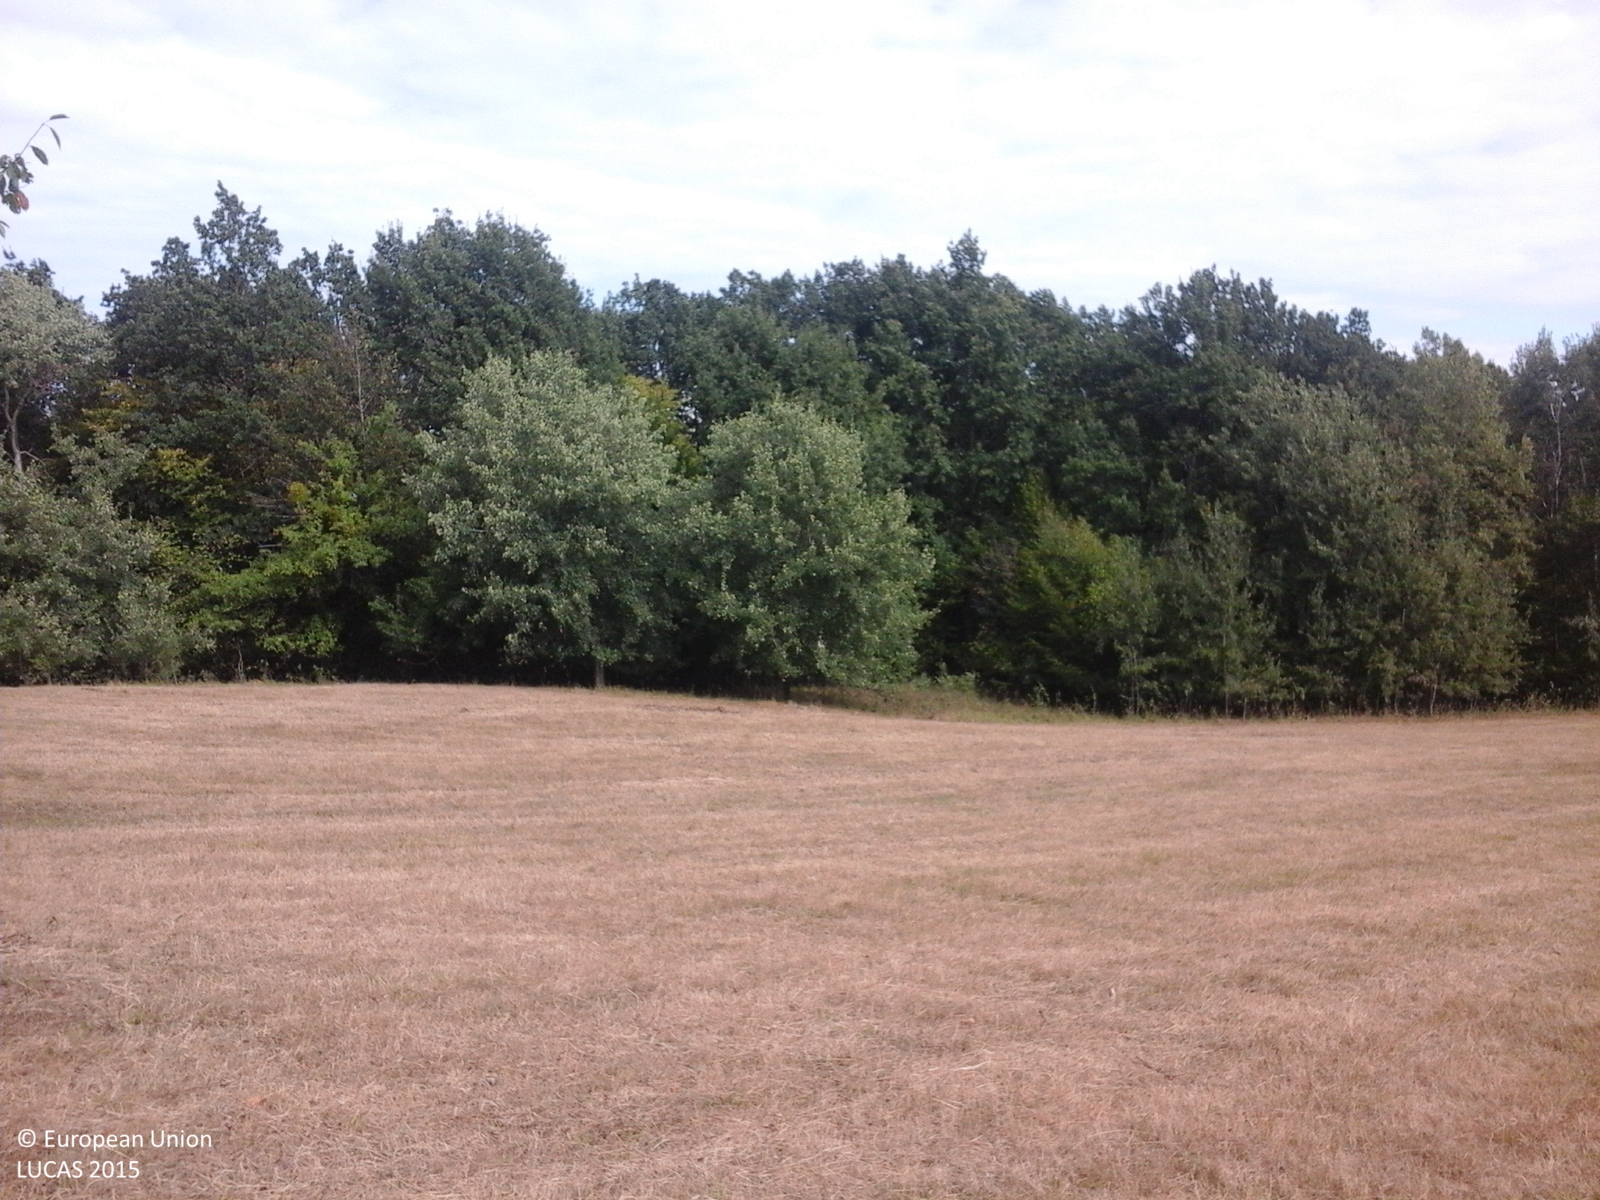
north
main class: Grassland
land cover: Grassland without tree/shrub cover
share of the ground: > 75 %
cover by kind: herbaceous plants 100 %
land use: Agriculture (excluding fallow land and kitchen gardens)
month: September
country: RO
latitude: 47.4744
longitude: 23.5422
